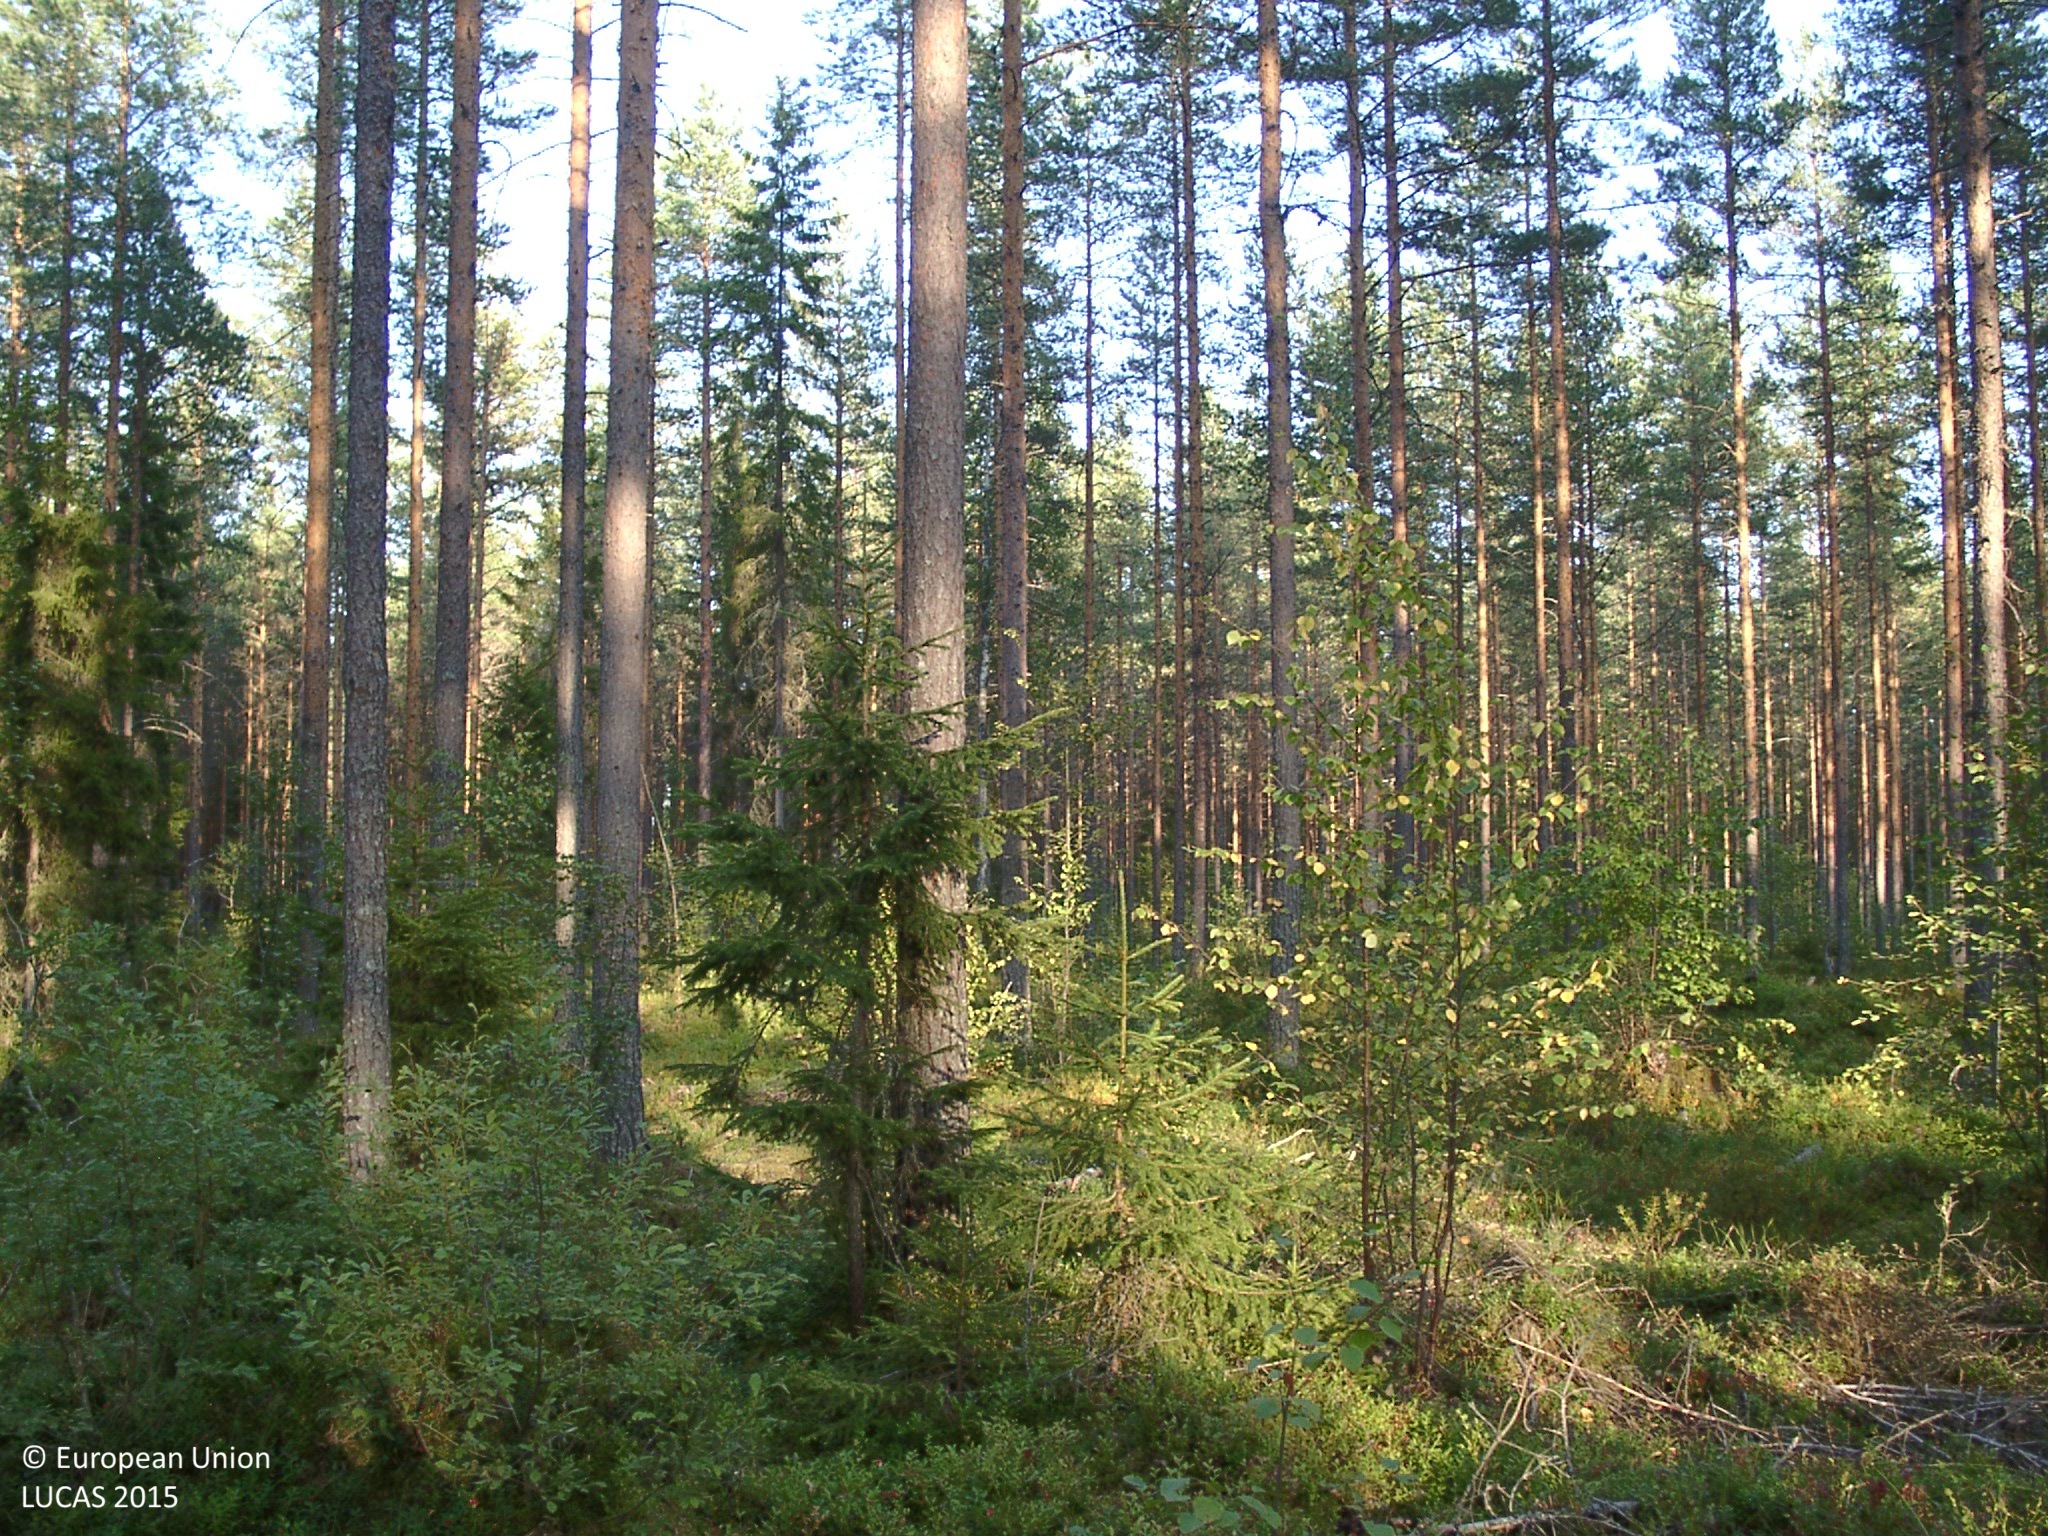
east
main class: Woodland
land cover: Pine dominated coniferous woodland
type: boreal forest
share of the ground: 50 - 75 %
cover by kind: coniferous forest trees 55 %, shrubs 30 %, lichens and mosses 10 %, broadleaved forest trees 5 %
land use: Forestry
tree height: > 5 m
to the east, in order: Pine dominated coniferous woodland; Shruby margins; Pine dominated coniferous woodland; Ditches and canals; Pine dominated coniferous woodland; Ditches and canals; Pine dominated coniferous woodland; Tracks; Pine dominated coniferous woodland; Shruby margins; Pine dominated coniferous woodland; Shruby margins; Other coniferous woodland; Other bare soil; Tracks; Shrubland without tree cover; Other mixed woodland
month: August
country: FI
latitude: 61.9361
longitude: 25.1033
